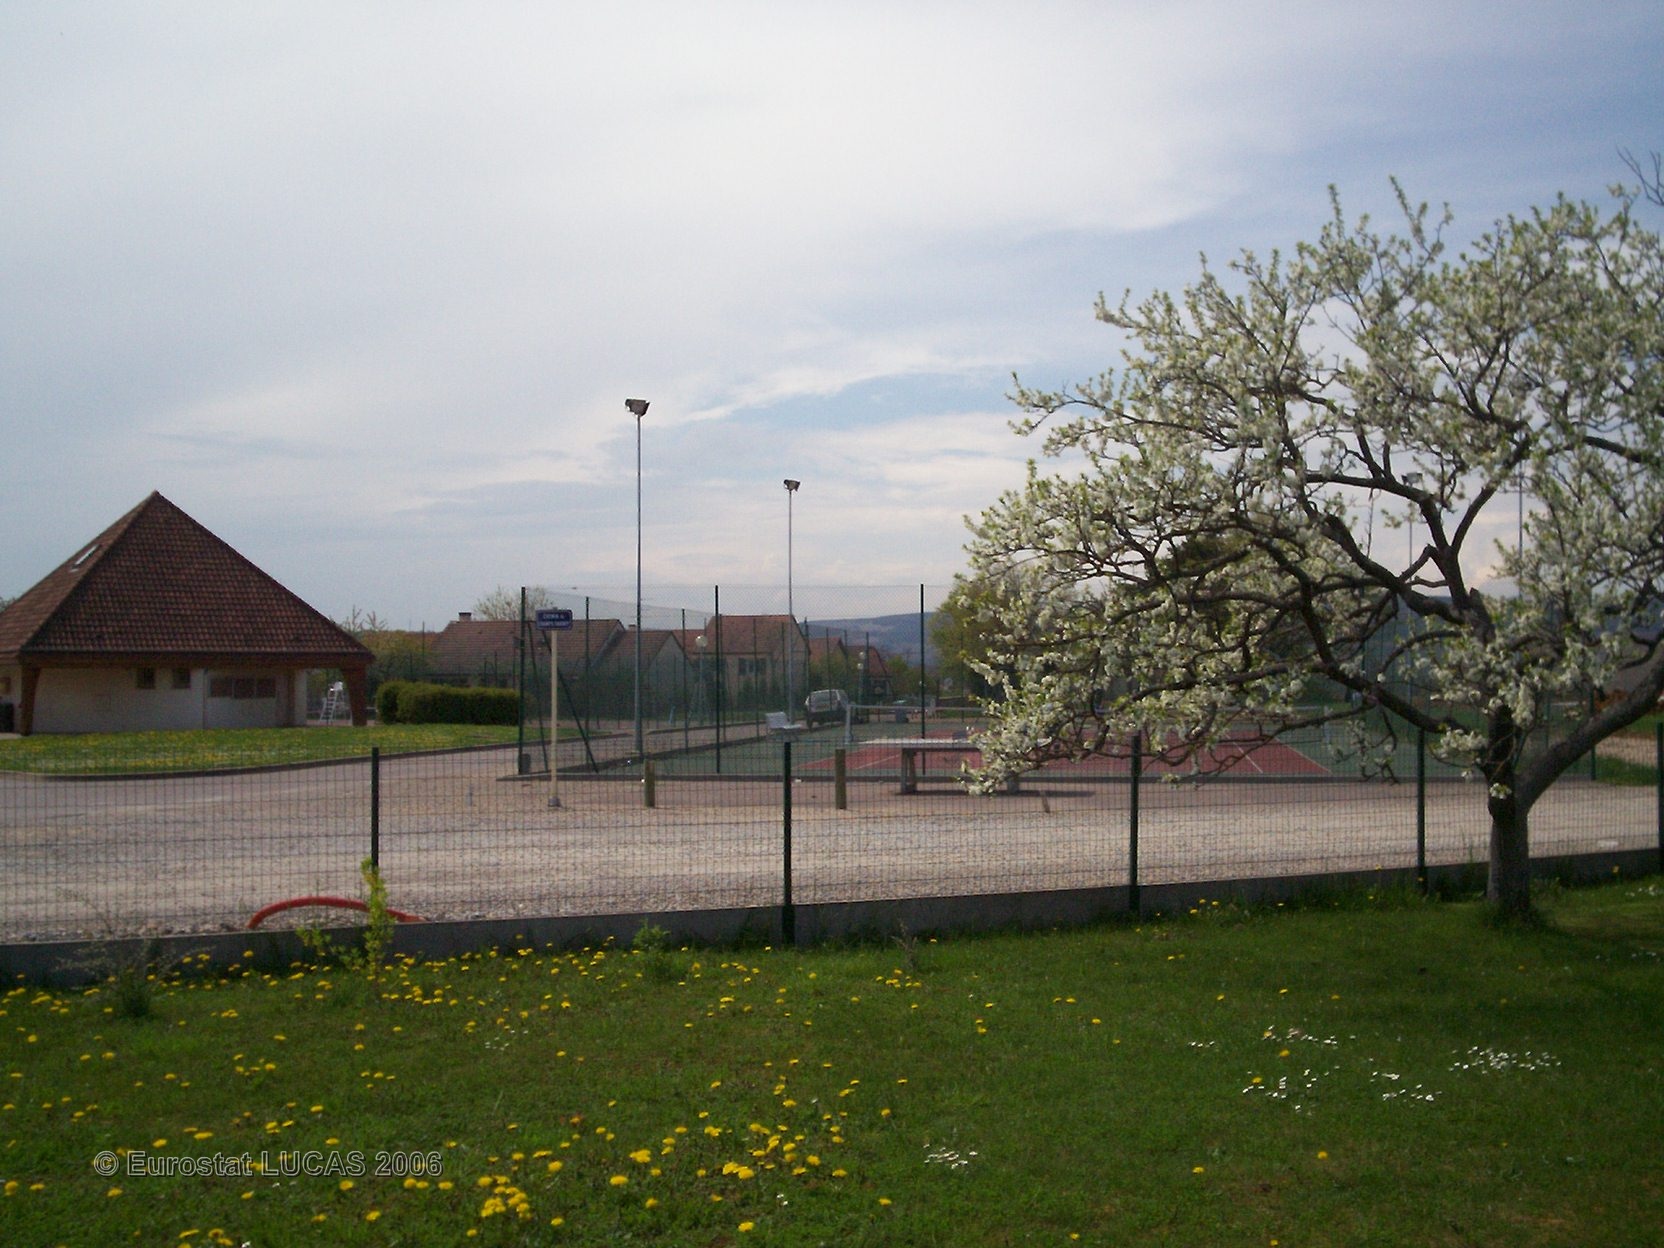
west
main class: Grassland
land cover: Grassland with sparse tree/shrub cover
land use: Residential
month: April
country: FR
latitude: 46.9086
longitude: 4.7625
